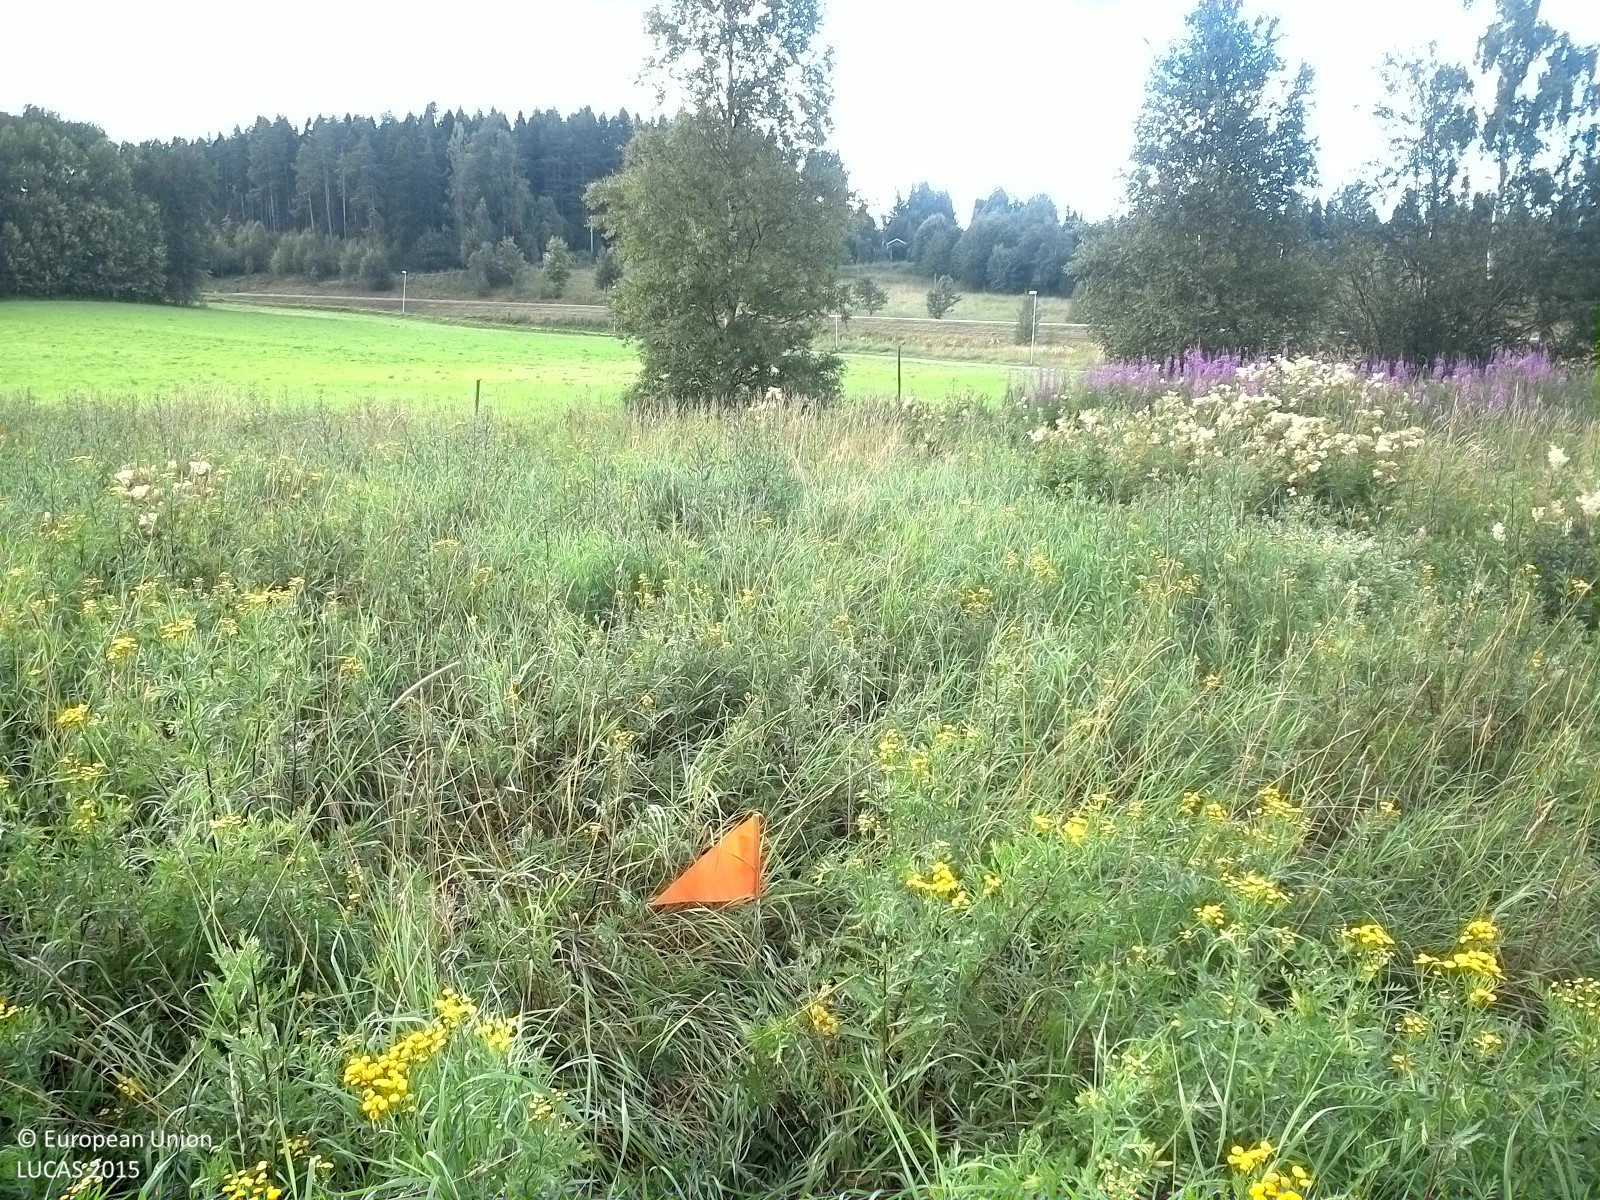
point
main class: Grassland
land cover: Grassland without tree/shrub cover
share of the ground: > 75 %
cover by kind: herbaceous plants 100 %
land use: Agriculture (excluding fallow land and kitchen gardens)
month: August
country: SE
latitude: 62.4181
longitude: 17.2788
